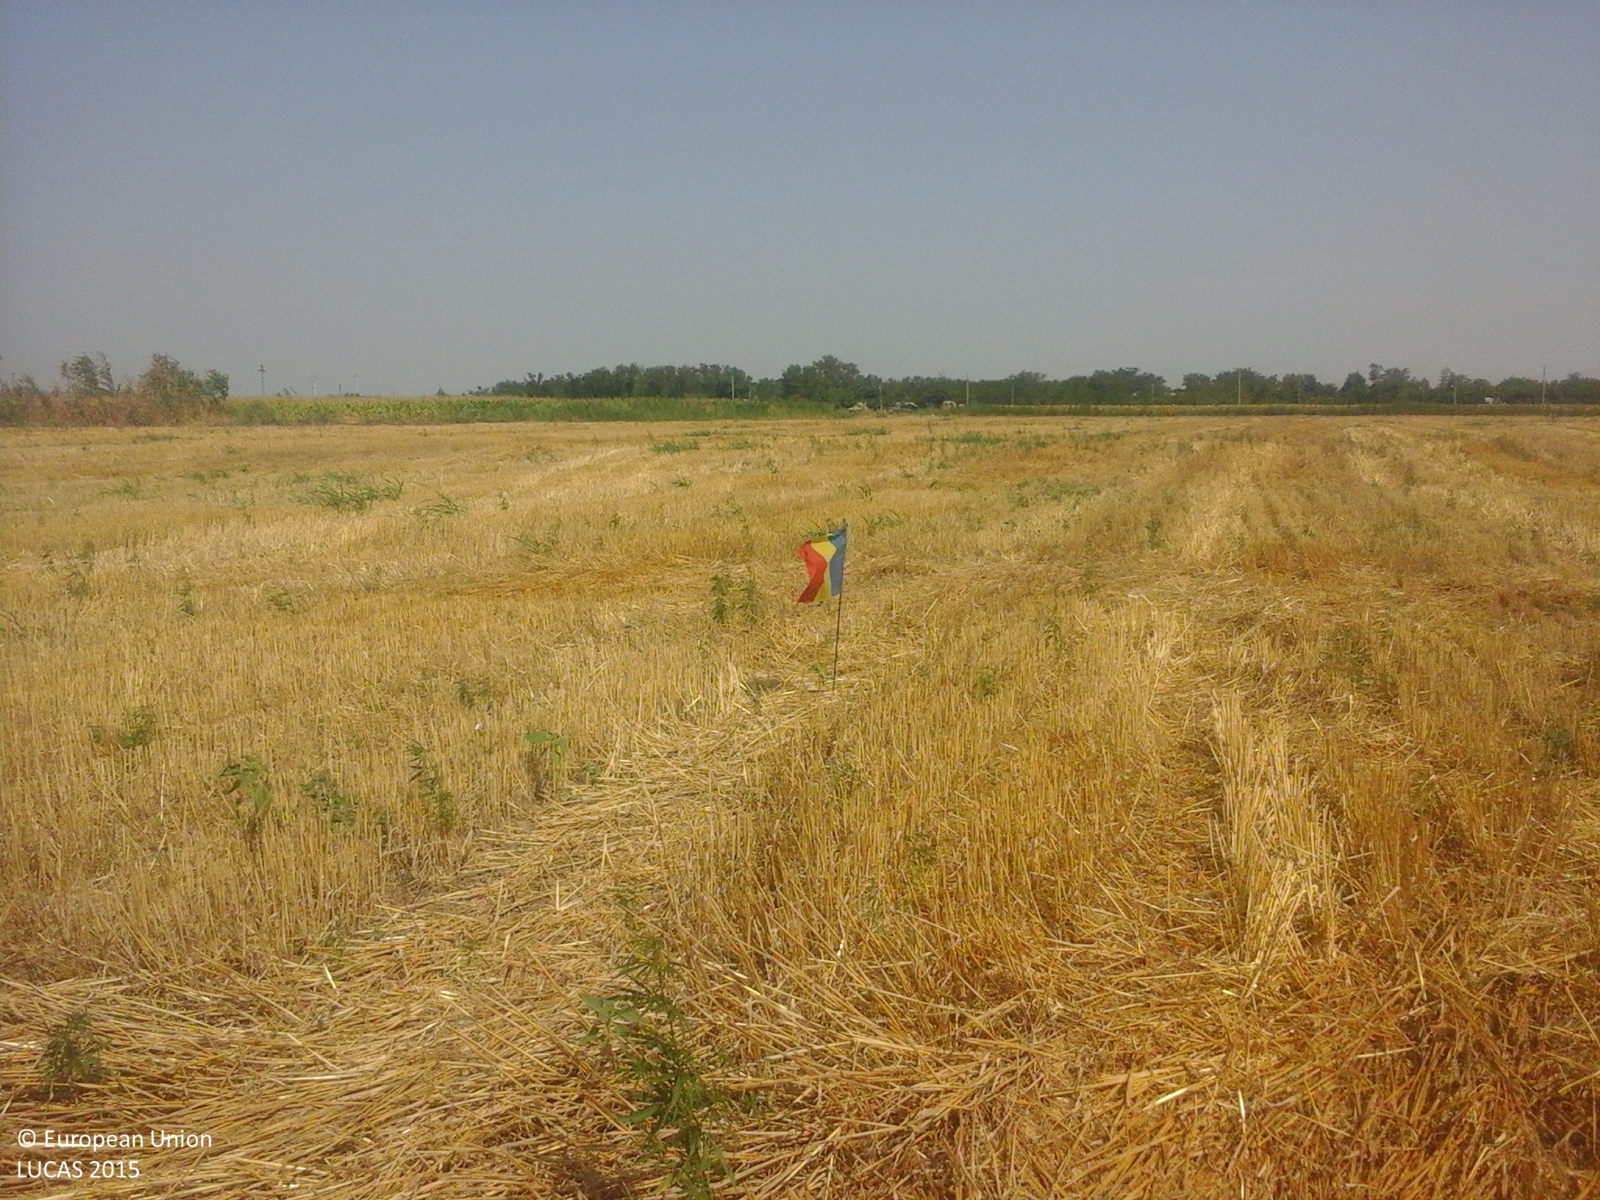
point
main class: Cropland
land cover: Common wheat
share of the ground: > 75 %
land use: Agriculture (excluding fallow land and kitchen gardens)
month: August
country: RO
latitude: 45.1050
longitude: 27.3402
